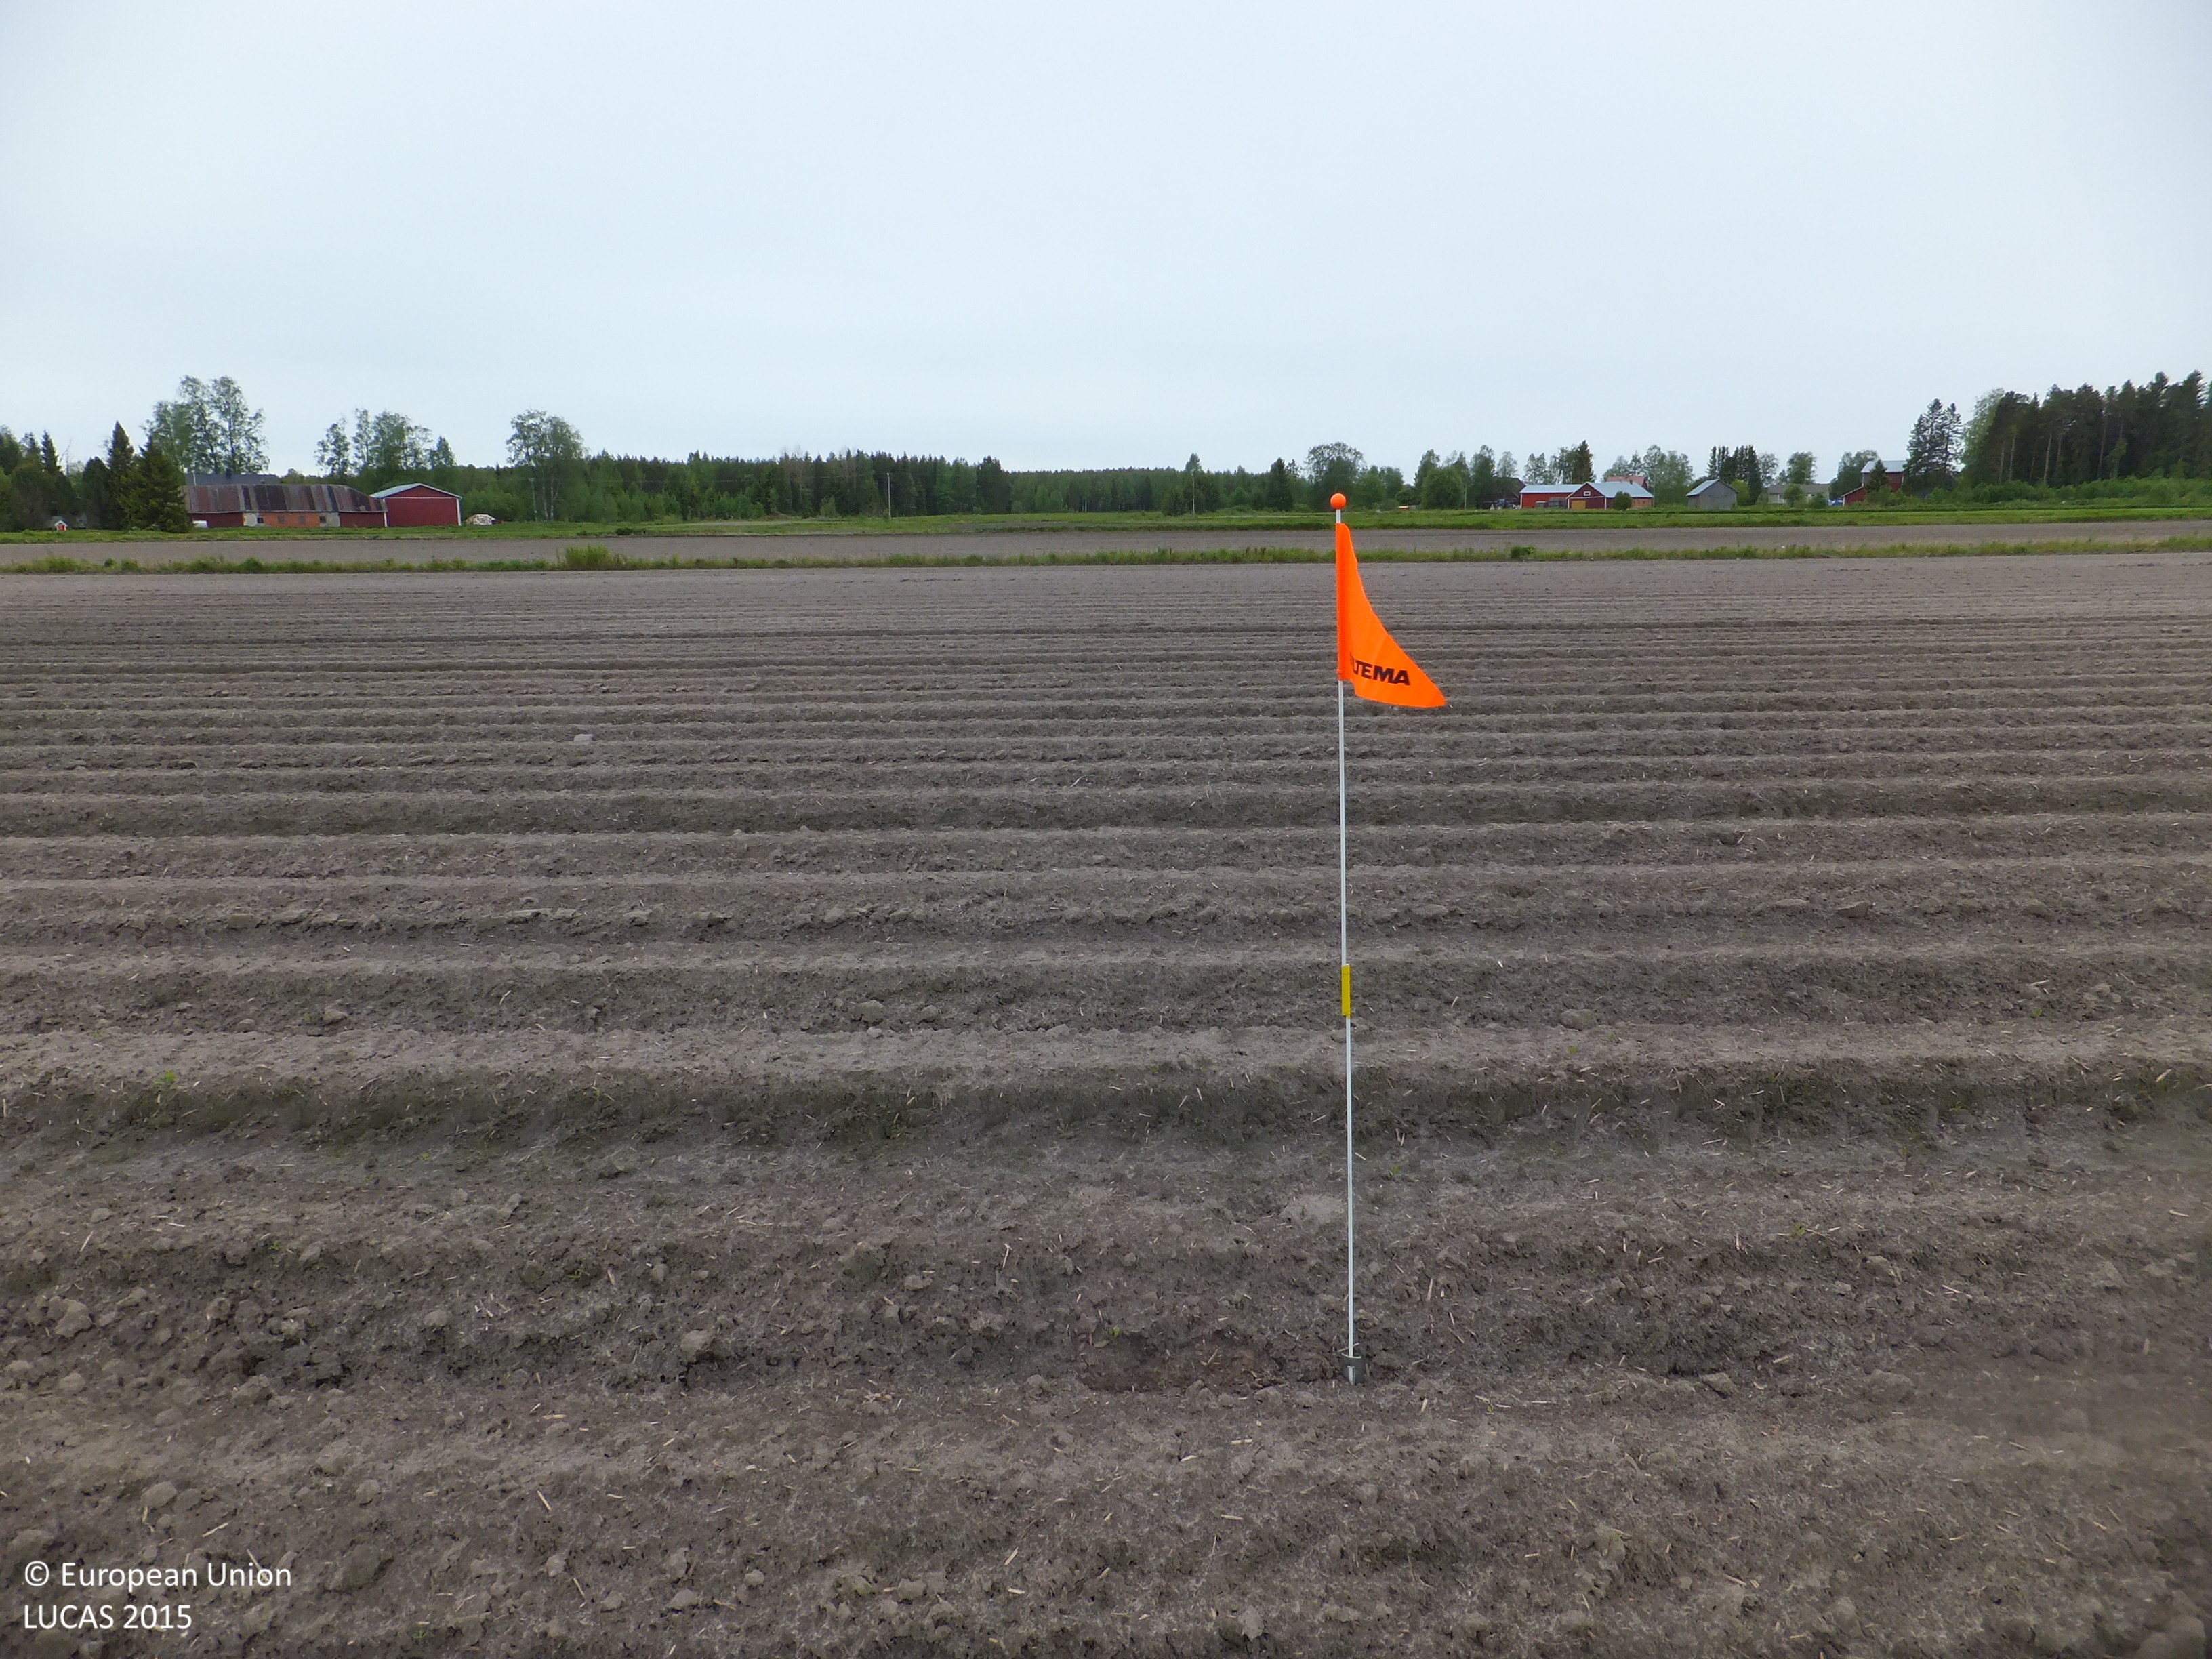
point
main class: Cropland
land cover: Potatoes
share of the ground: < 10 %
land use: Agriculture (excluding fallow land and kitchen gardens)
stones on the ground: < 10 %
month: June
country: FI
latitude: 63.2798
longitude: 22.7105
